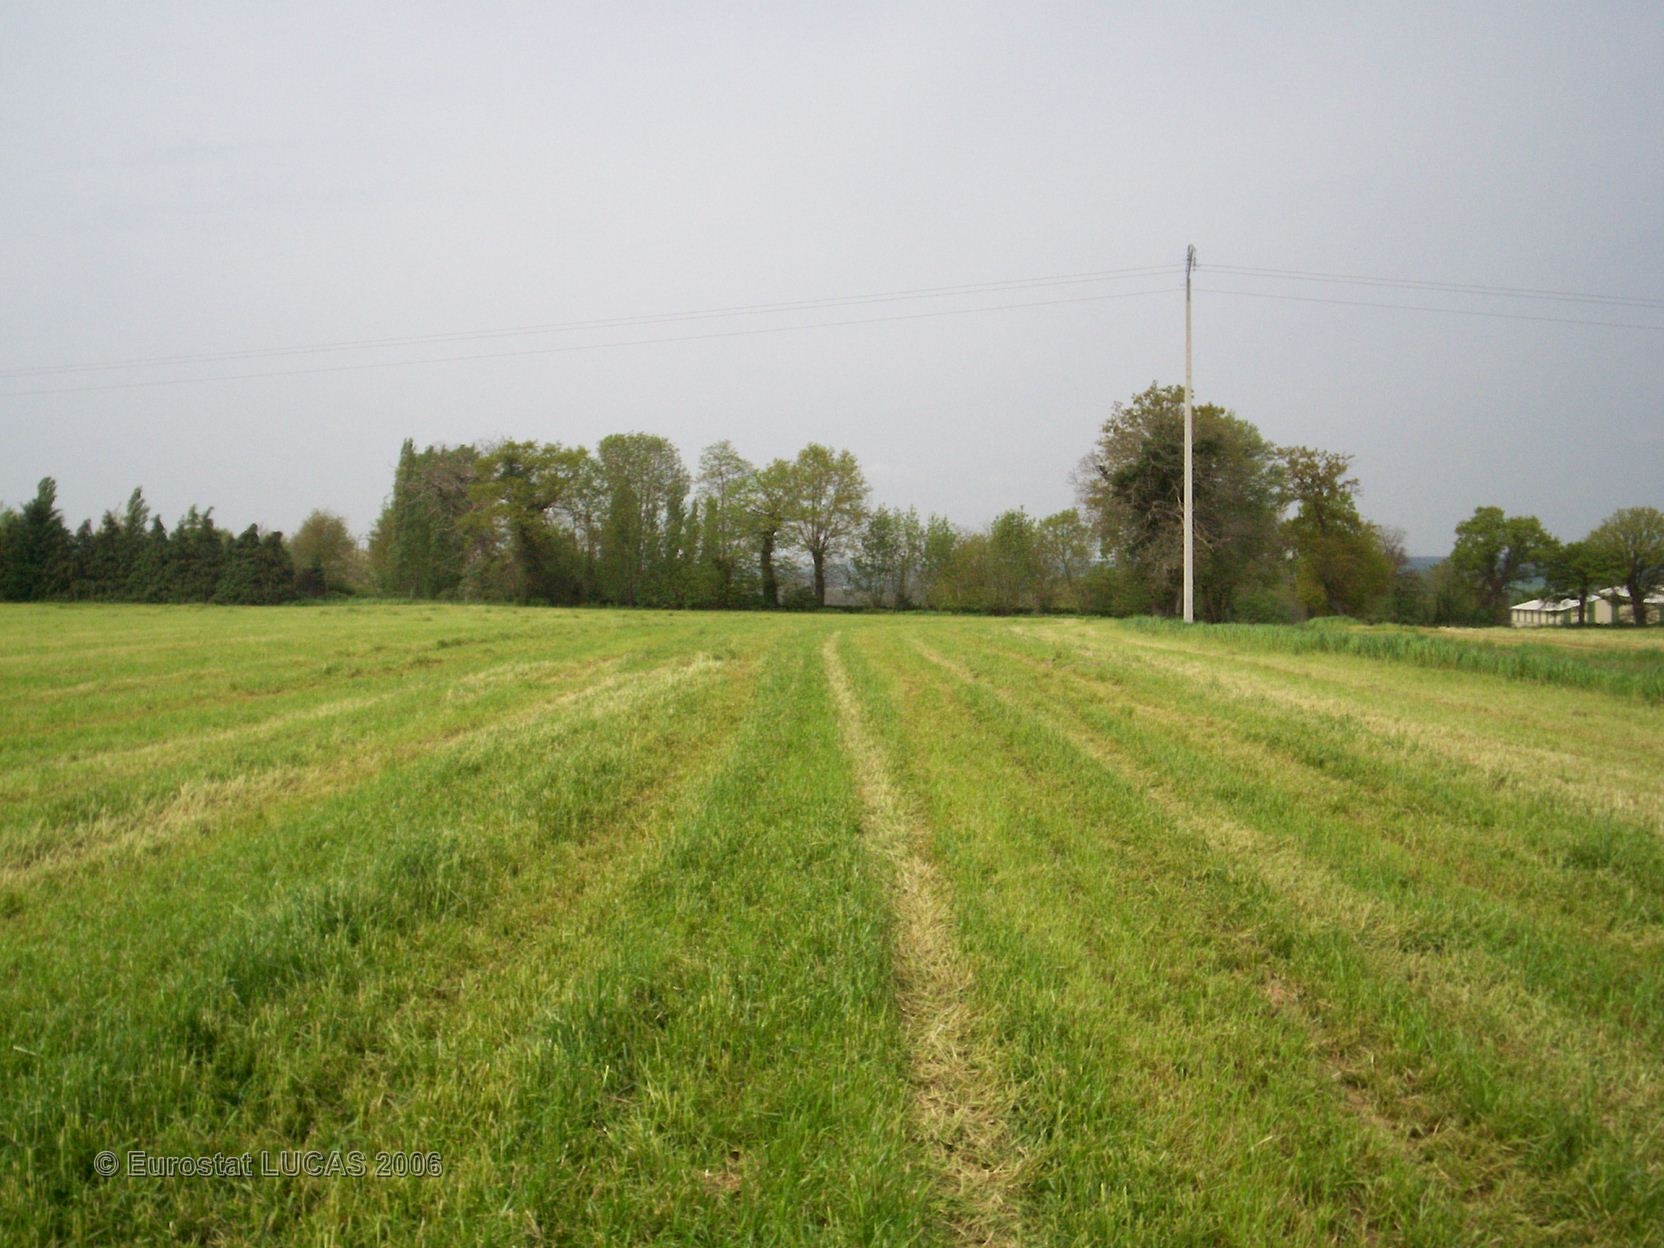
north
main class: Grassland
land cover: Grassland without tree/shrub cover
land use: Agriculture (excluding fallow land and kitchen gardens)
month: May
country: FR
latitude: 47.7221
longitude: -2.2255
